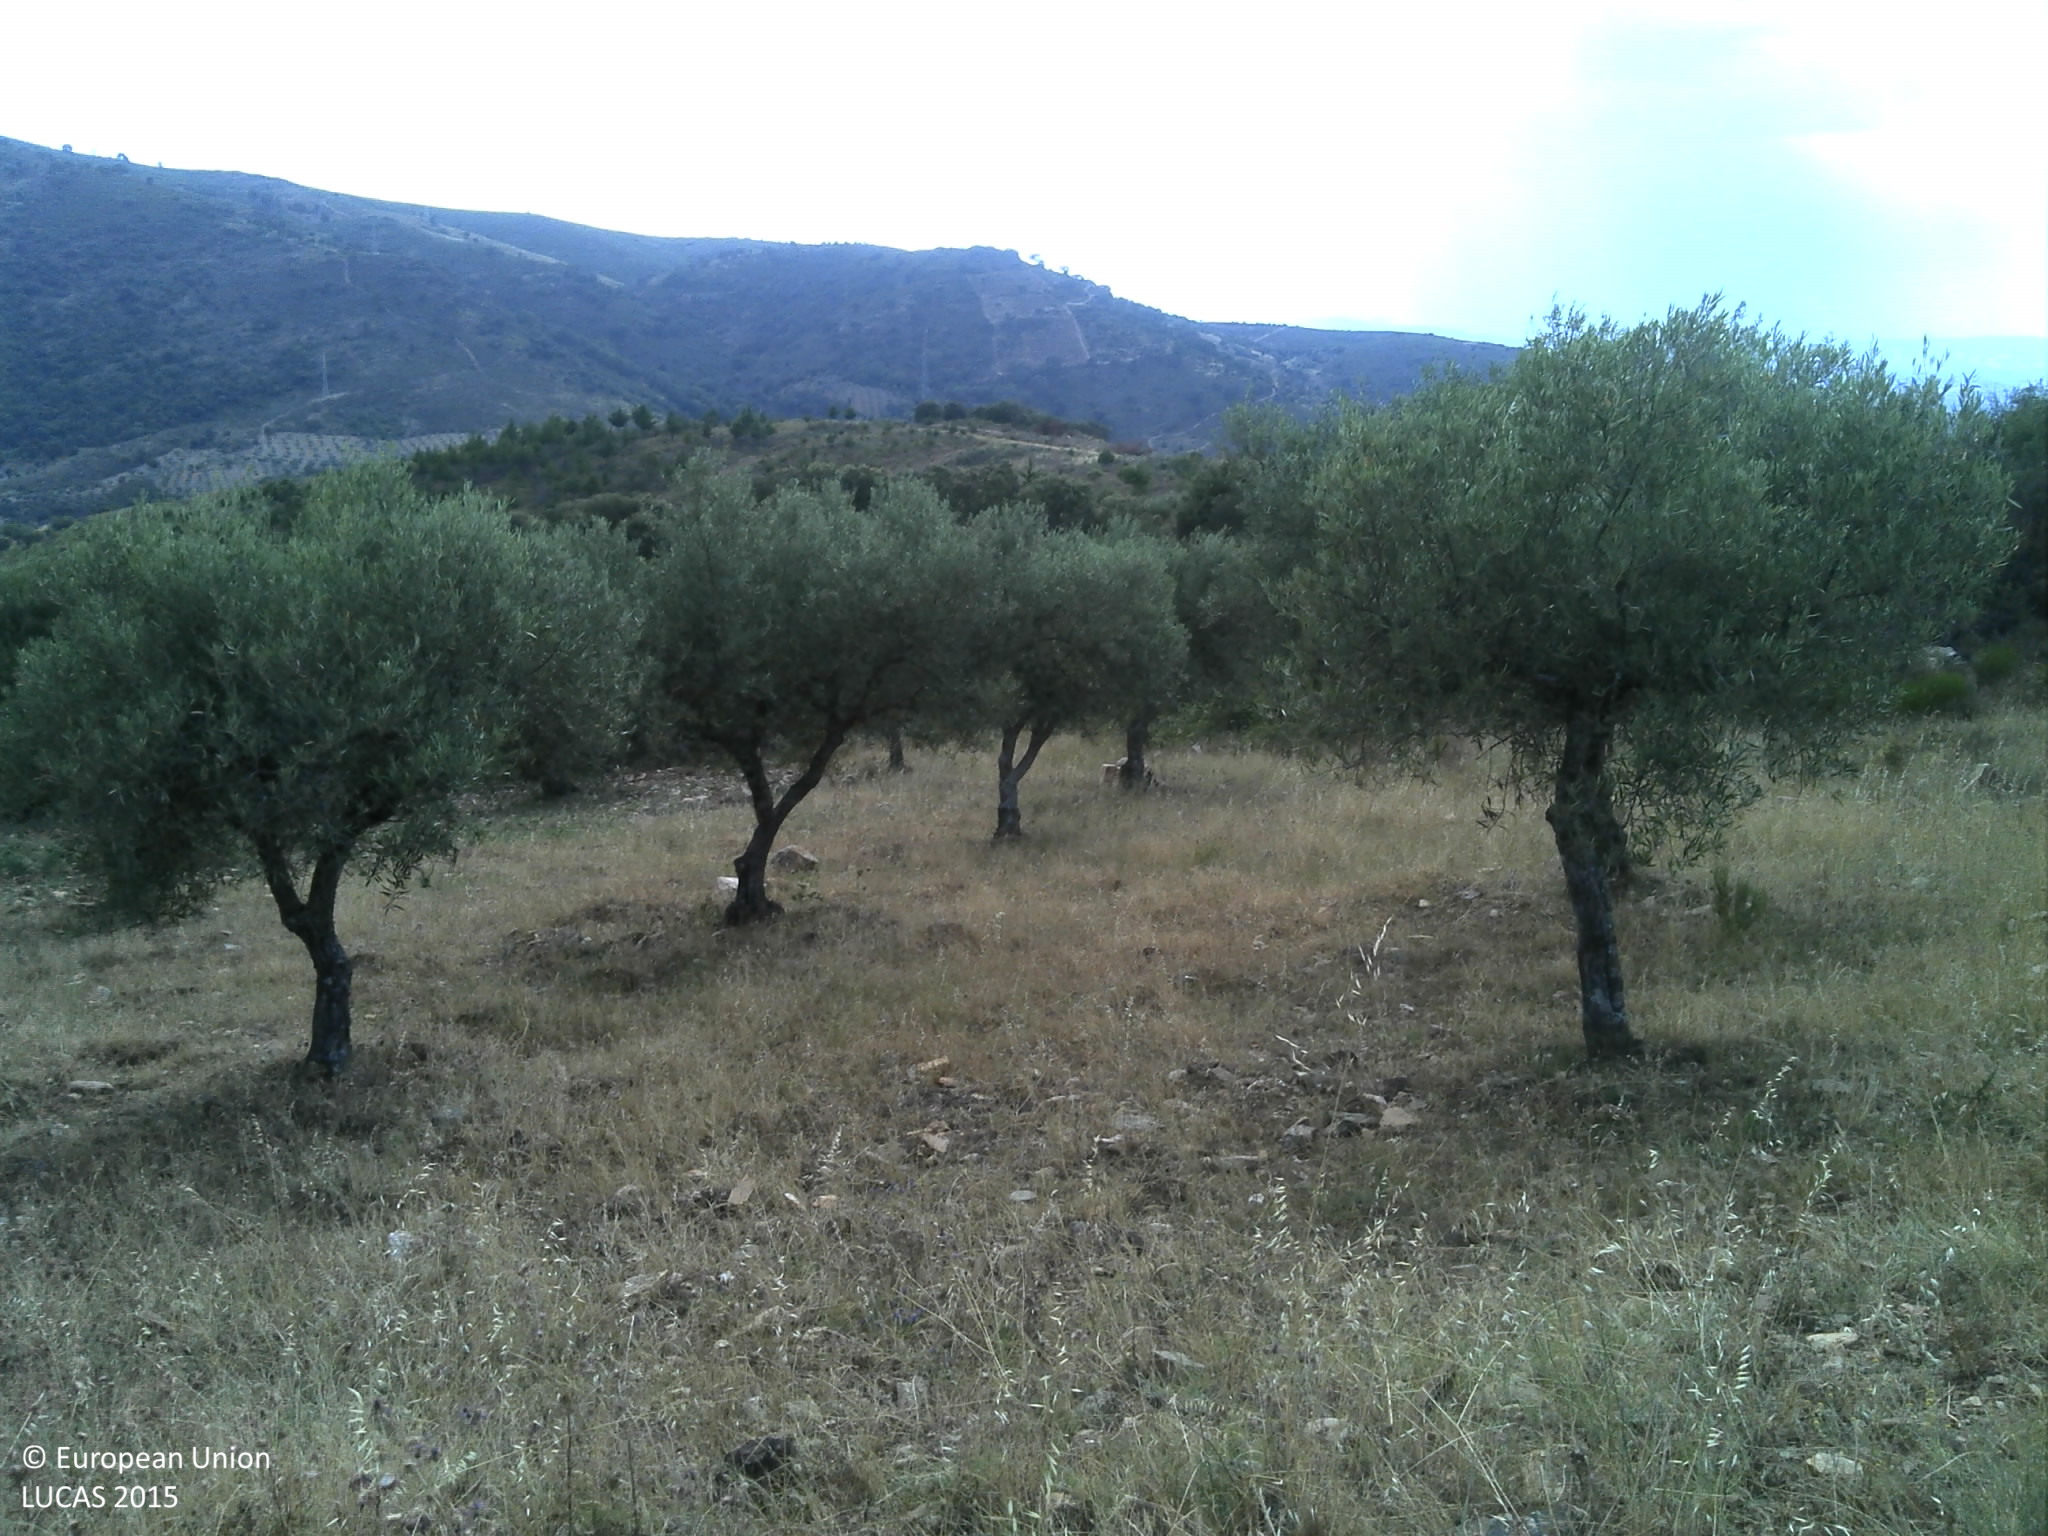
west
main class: Cropland
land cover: Olive groves
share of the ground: < 10 %
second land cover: Spontaneously vegetated surfaces
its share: 25 - 50 %
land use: Agriculture (excluding fallow land and kitchen gardens)
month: June
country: PT
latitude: 41.4800
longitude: -7.1106
